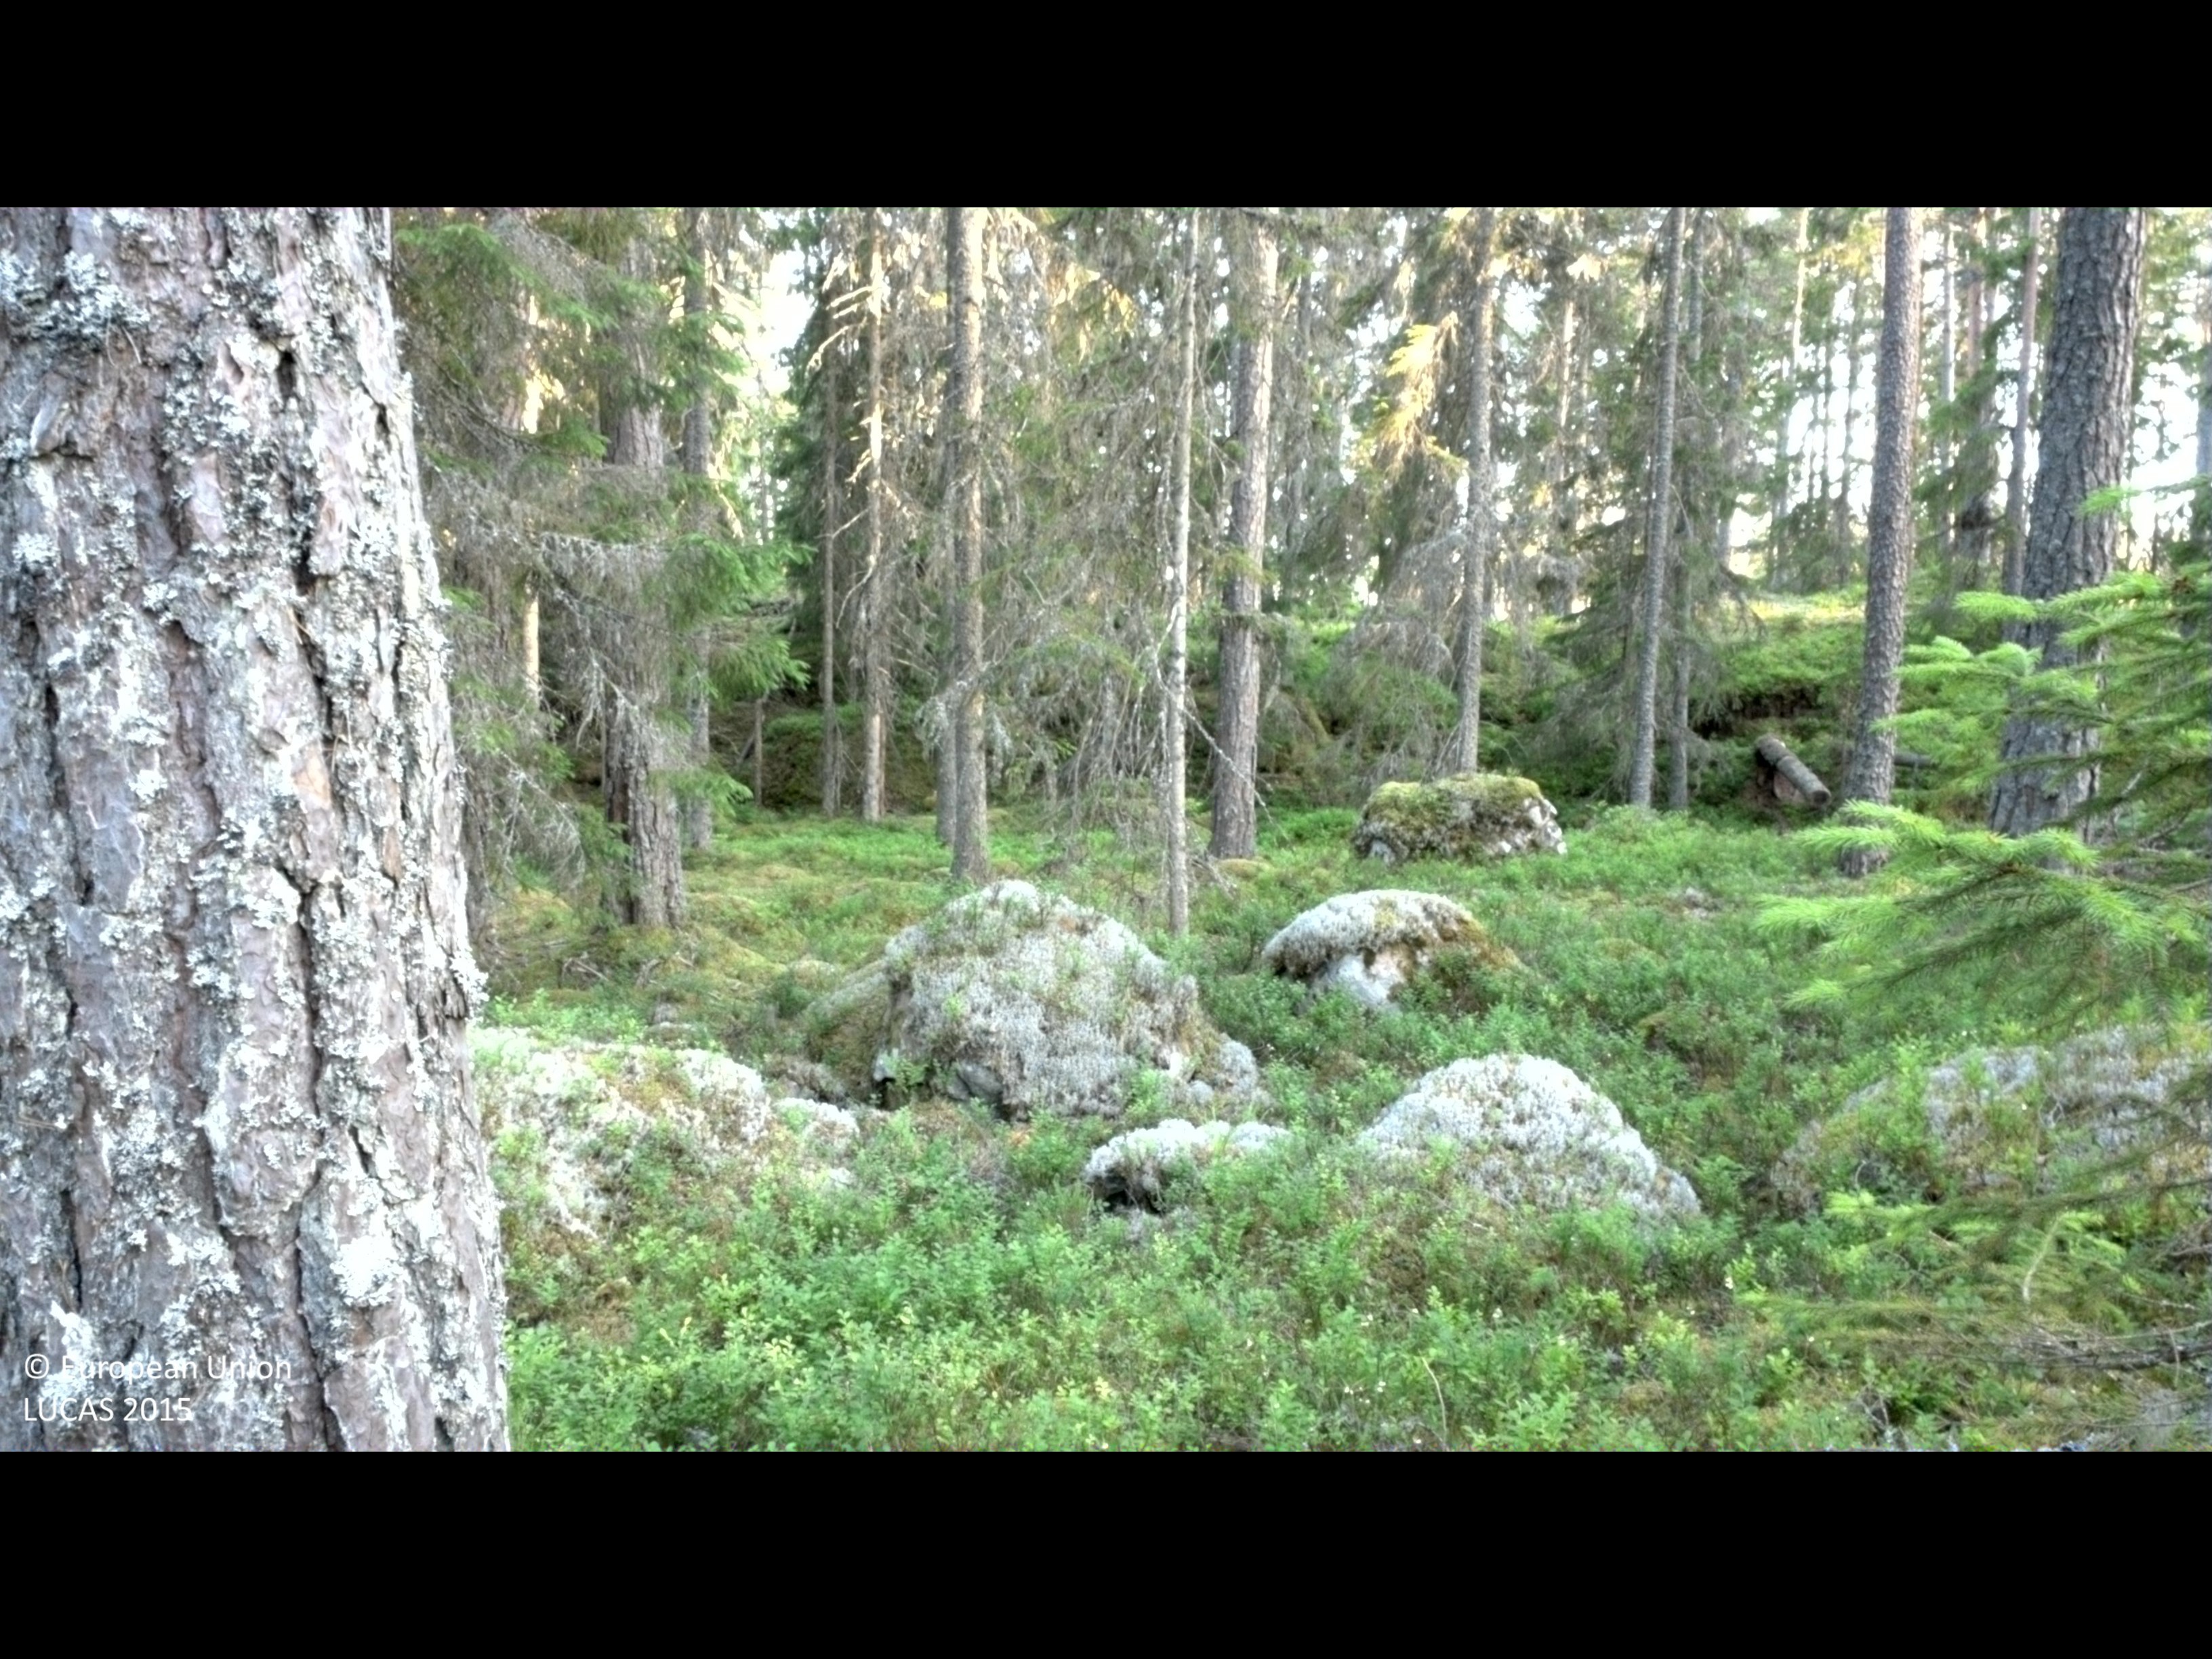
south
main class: Woodland
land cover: Pine dominated coniferous woodland
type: boreal forest
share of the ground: 50 - 75 %
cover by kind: coniferous forest trees 65 %, shrubs 30 %, lichens and mosses 5 %
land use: Amenities, museums, leisure
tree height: > 5 m
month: June
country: SE
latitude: 58.2204
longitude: 16.2100
